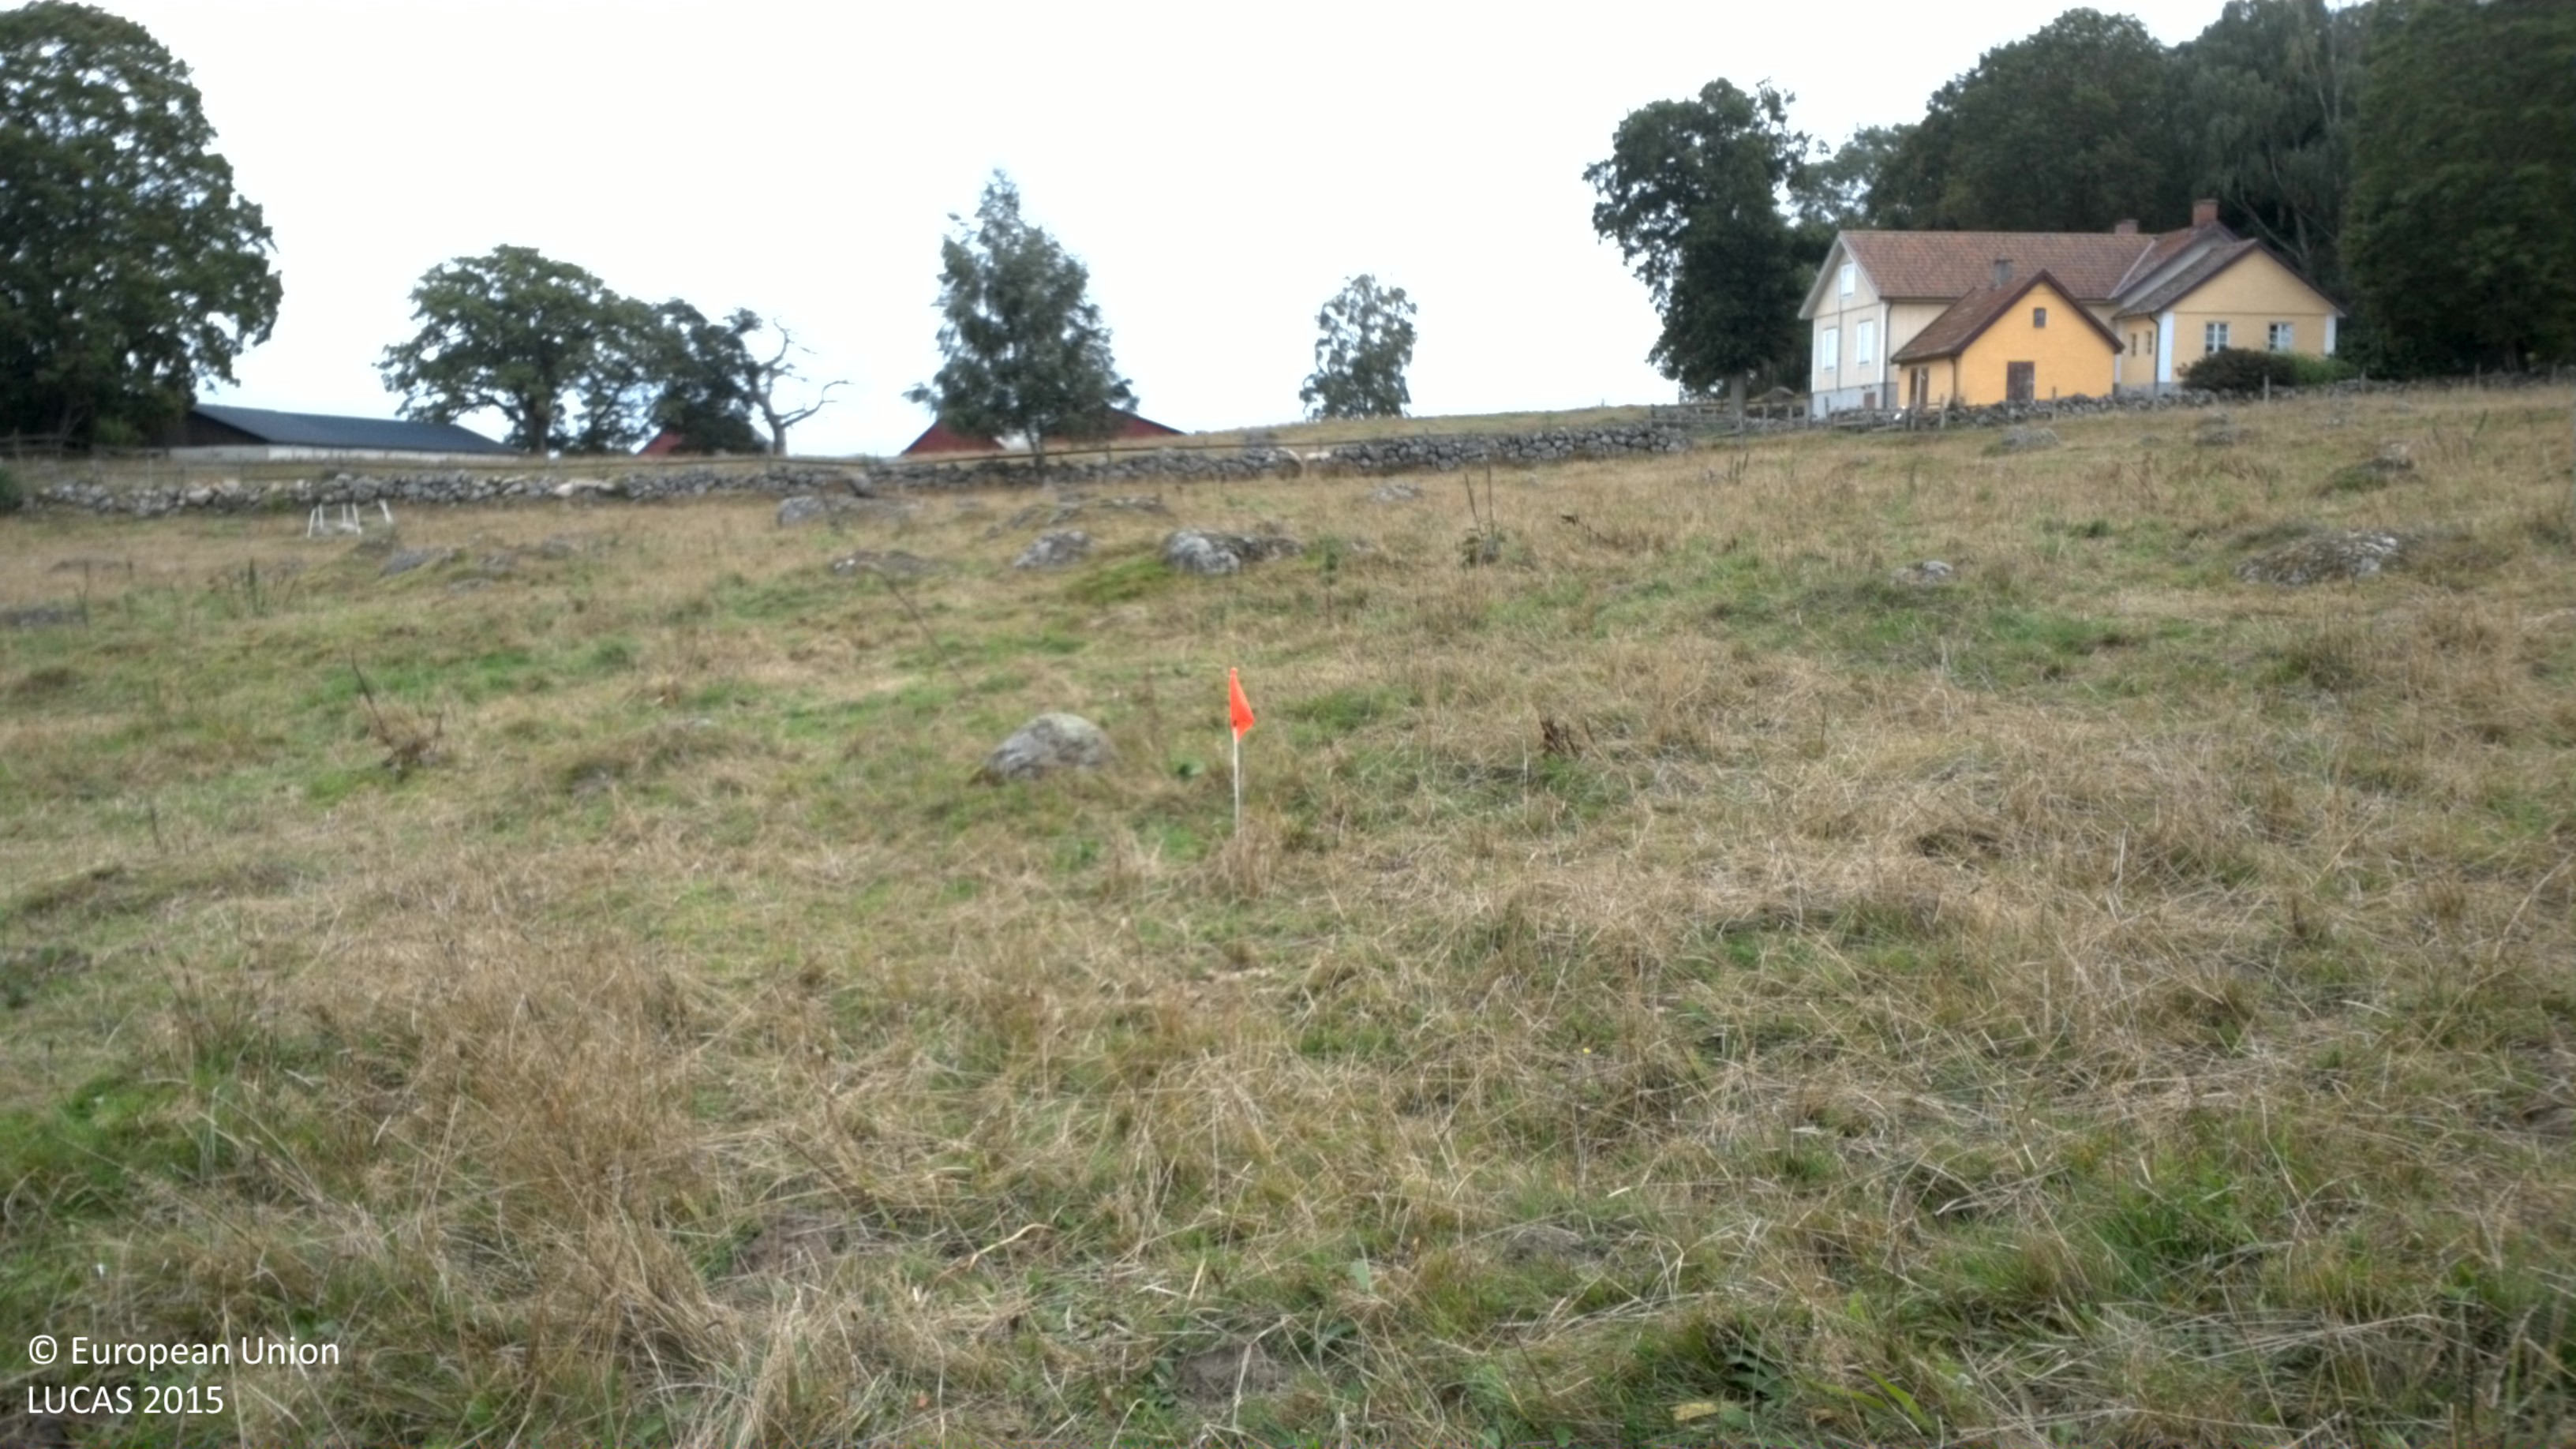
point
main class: Grassland
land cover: Grassland without tree/shrub cover
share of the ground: > 75 %
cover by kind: herbaceous plants 100 %
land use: Agriculture (excluding fallow land and kitchen gardens)
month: September
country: SE
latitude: 56.1244
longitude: 14.0354
